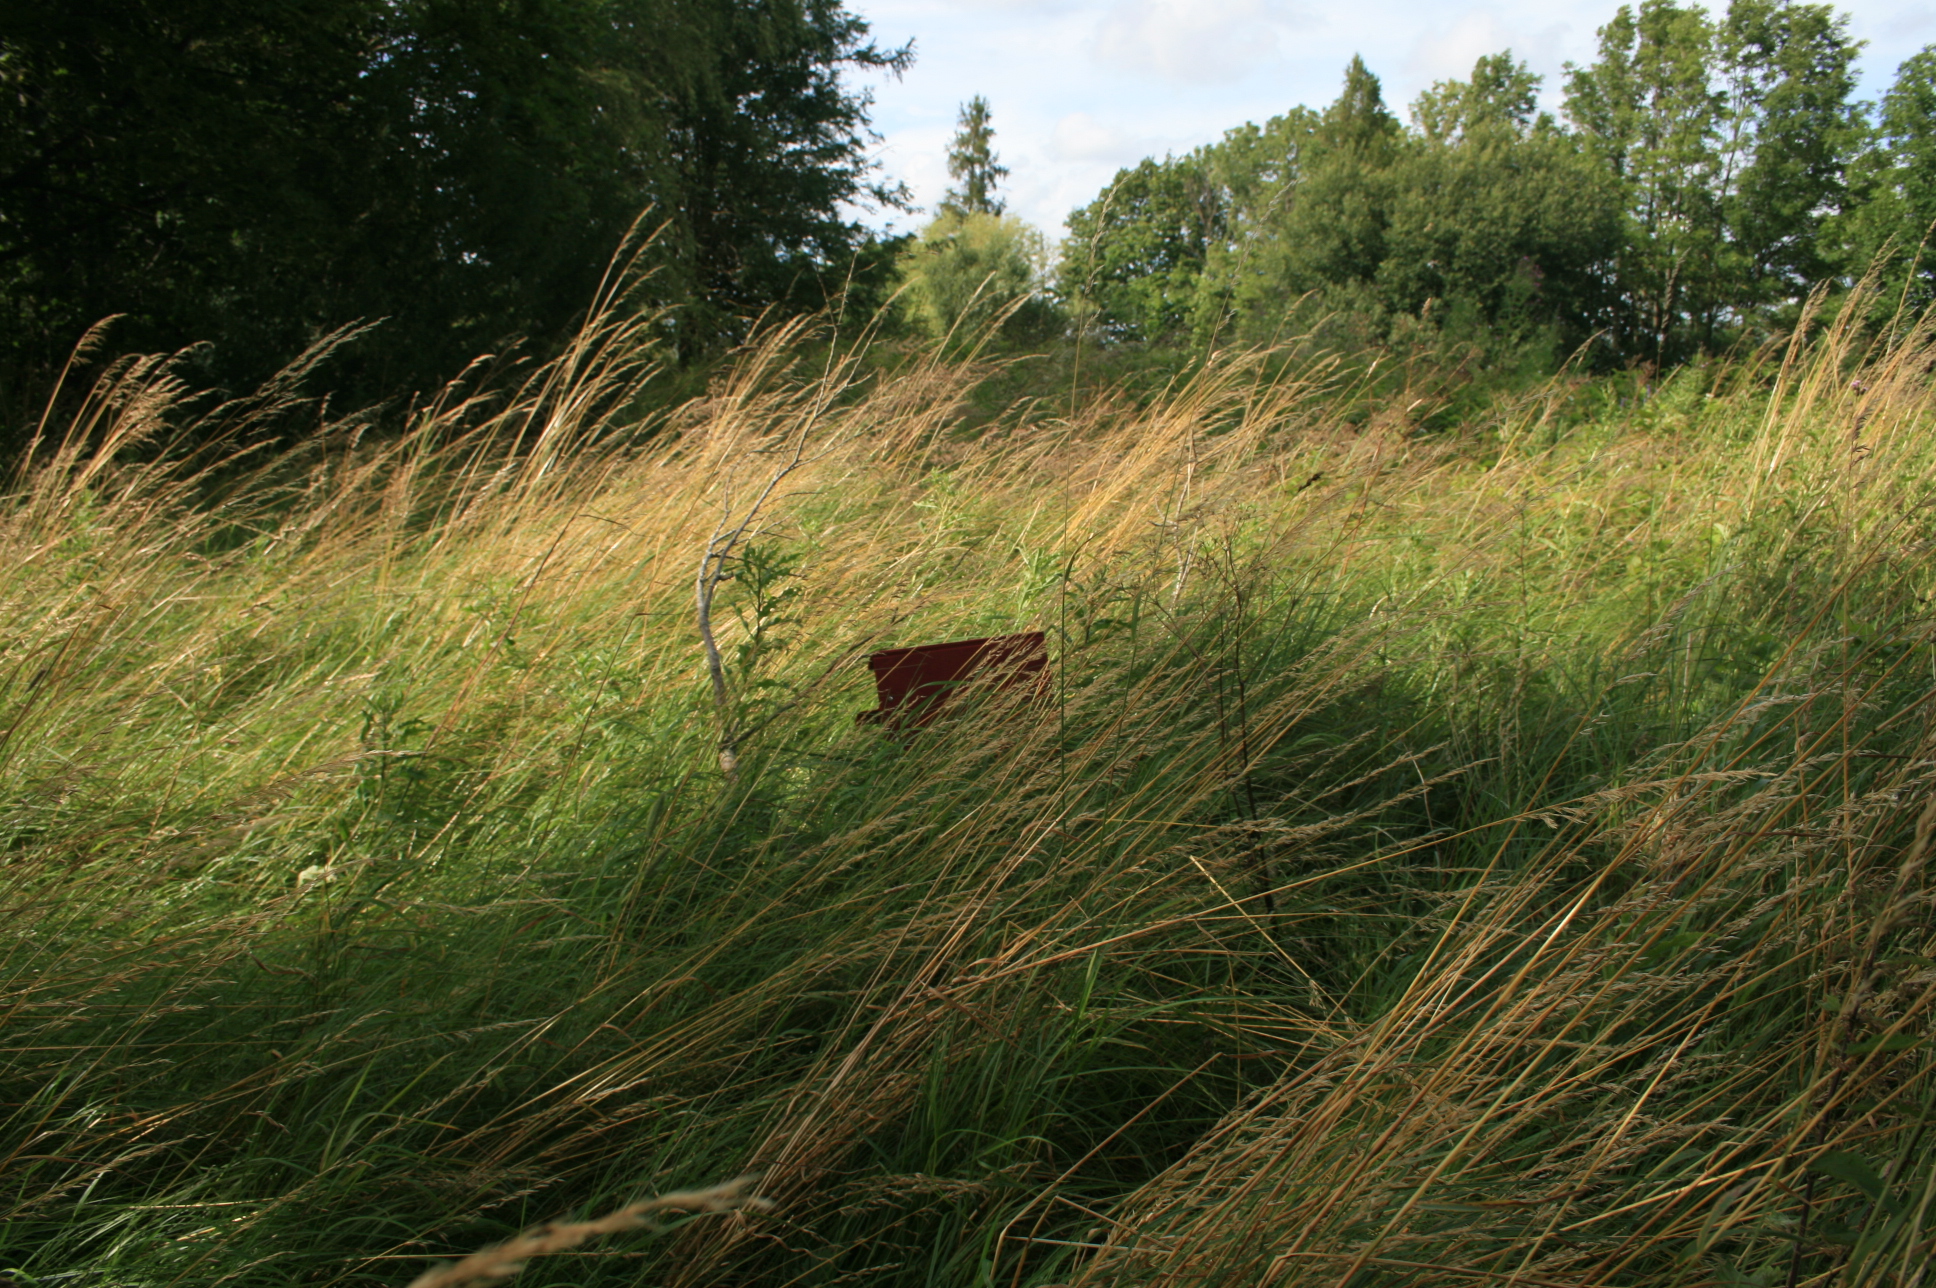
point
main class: Grassland
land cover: Grassland with sparse tree/shrub cover
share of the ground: > 75 %
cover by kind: herbaceous plants 90 %, broadleaved forest trees 5 %, shrubs 5 %
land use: Fallow land
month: July
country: LT
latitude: 55.5023
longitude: 21.3314
